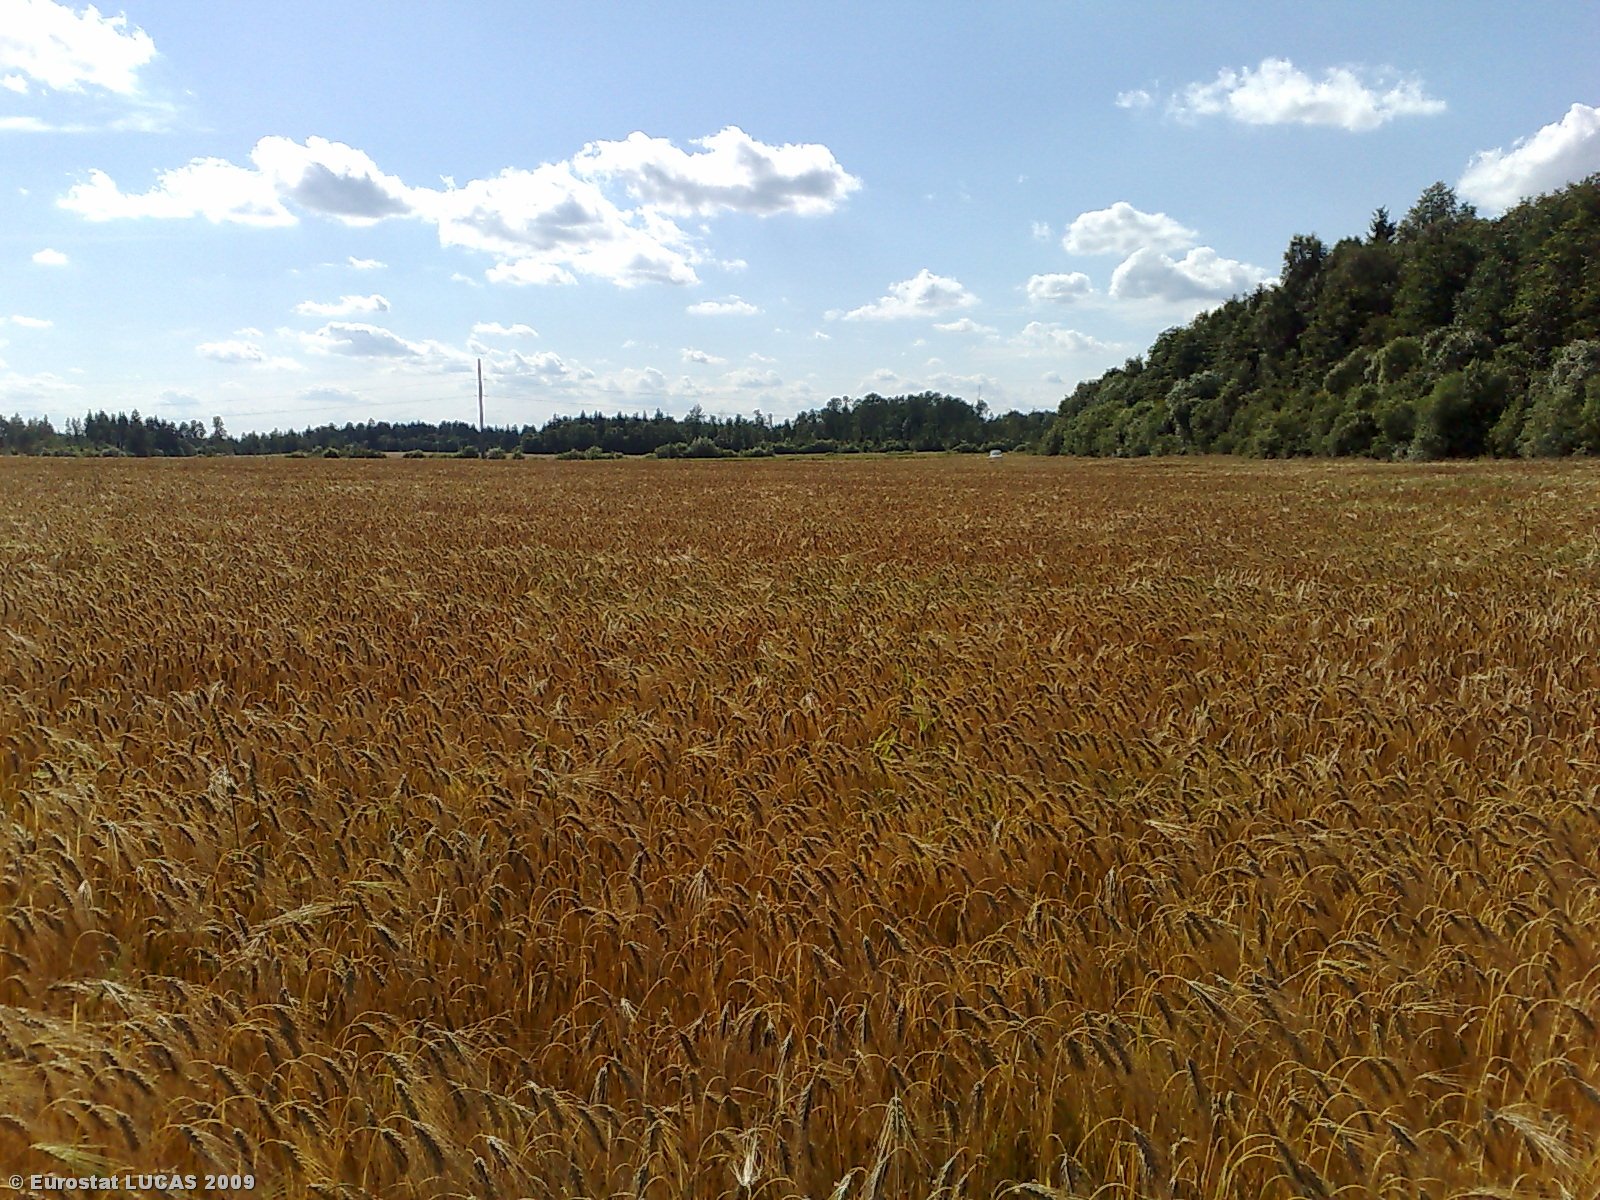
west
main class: Cropland
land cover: Triticale
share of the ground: > 75 %
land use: Agriculture (excluding fallow land and kitchen gardens)
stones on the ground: < 10 %
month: July
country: LT
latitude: 56.0942
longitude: 22.9416
